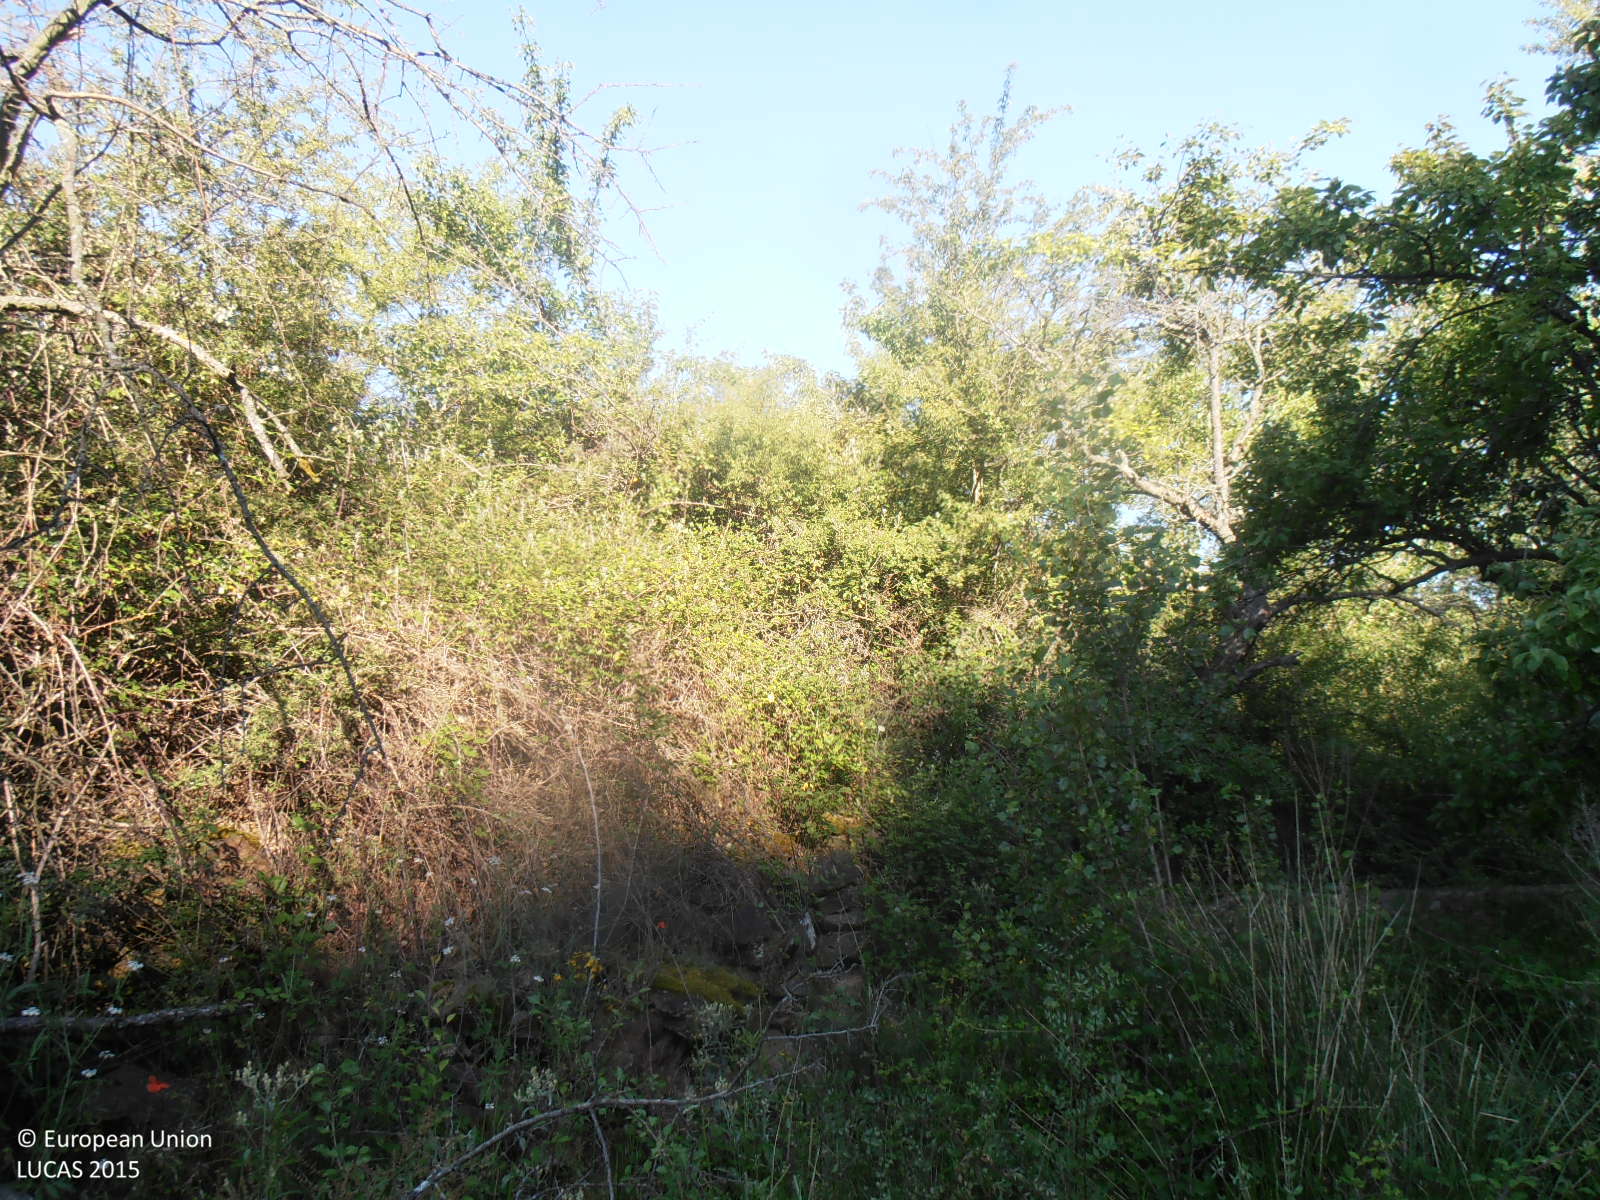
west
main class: Shrubland
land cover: Shrubland with sparse tree cover
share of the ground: > 75 %
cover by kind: shrubs 95 %, broadleaved forest trees 5 %
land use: Semi-natural and natural areas not in use
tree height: > 5 m
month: June
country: ES
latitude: 41.4067
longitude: -1.3998
